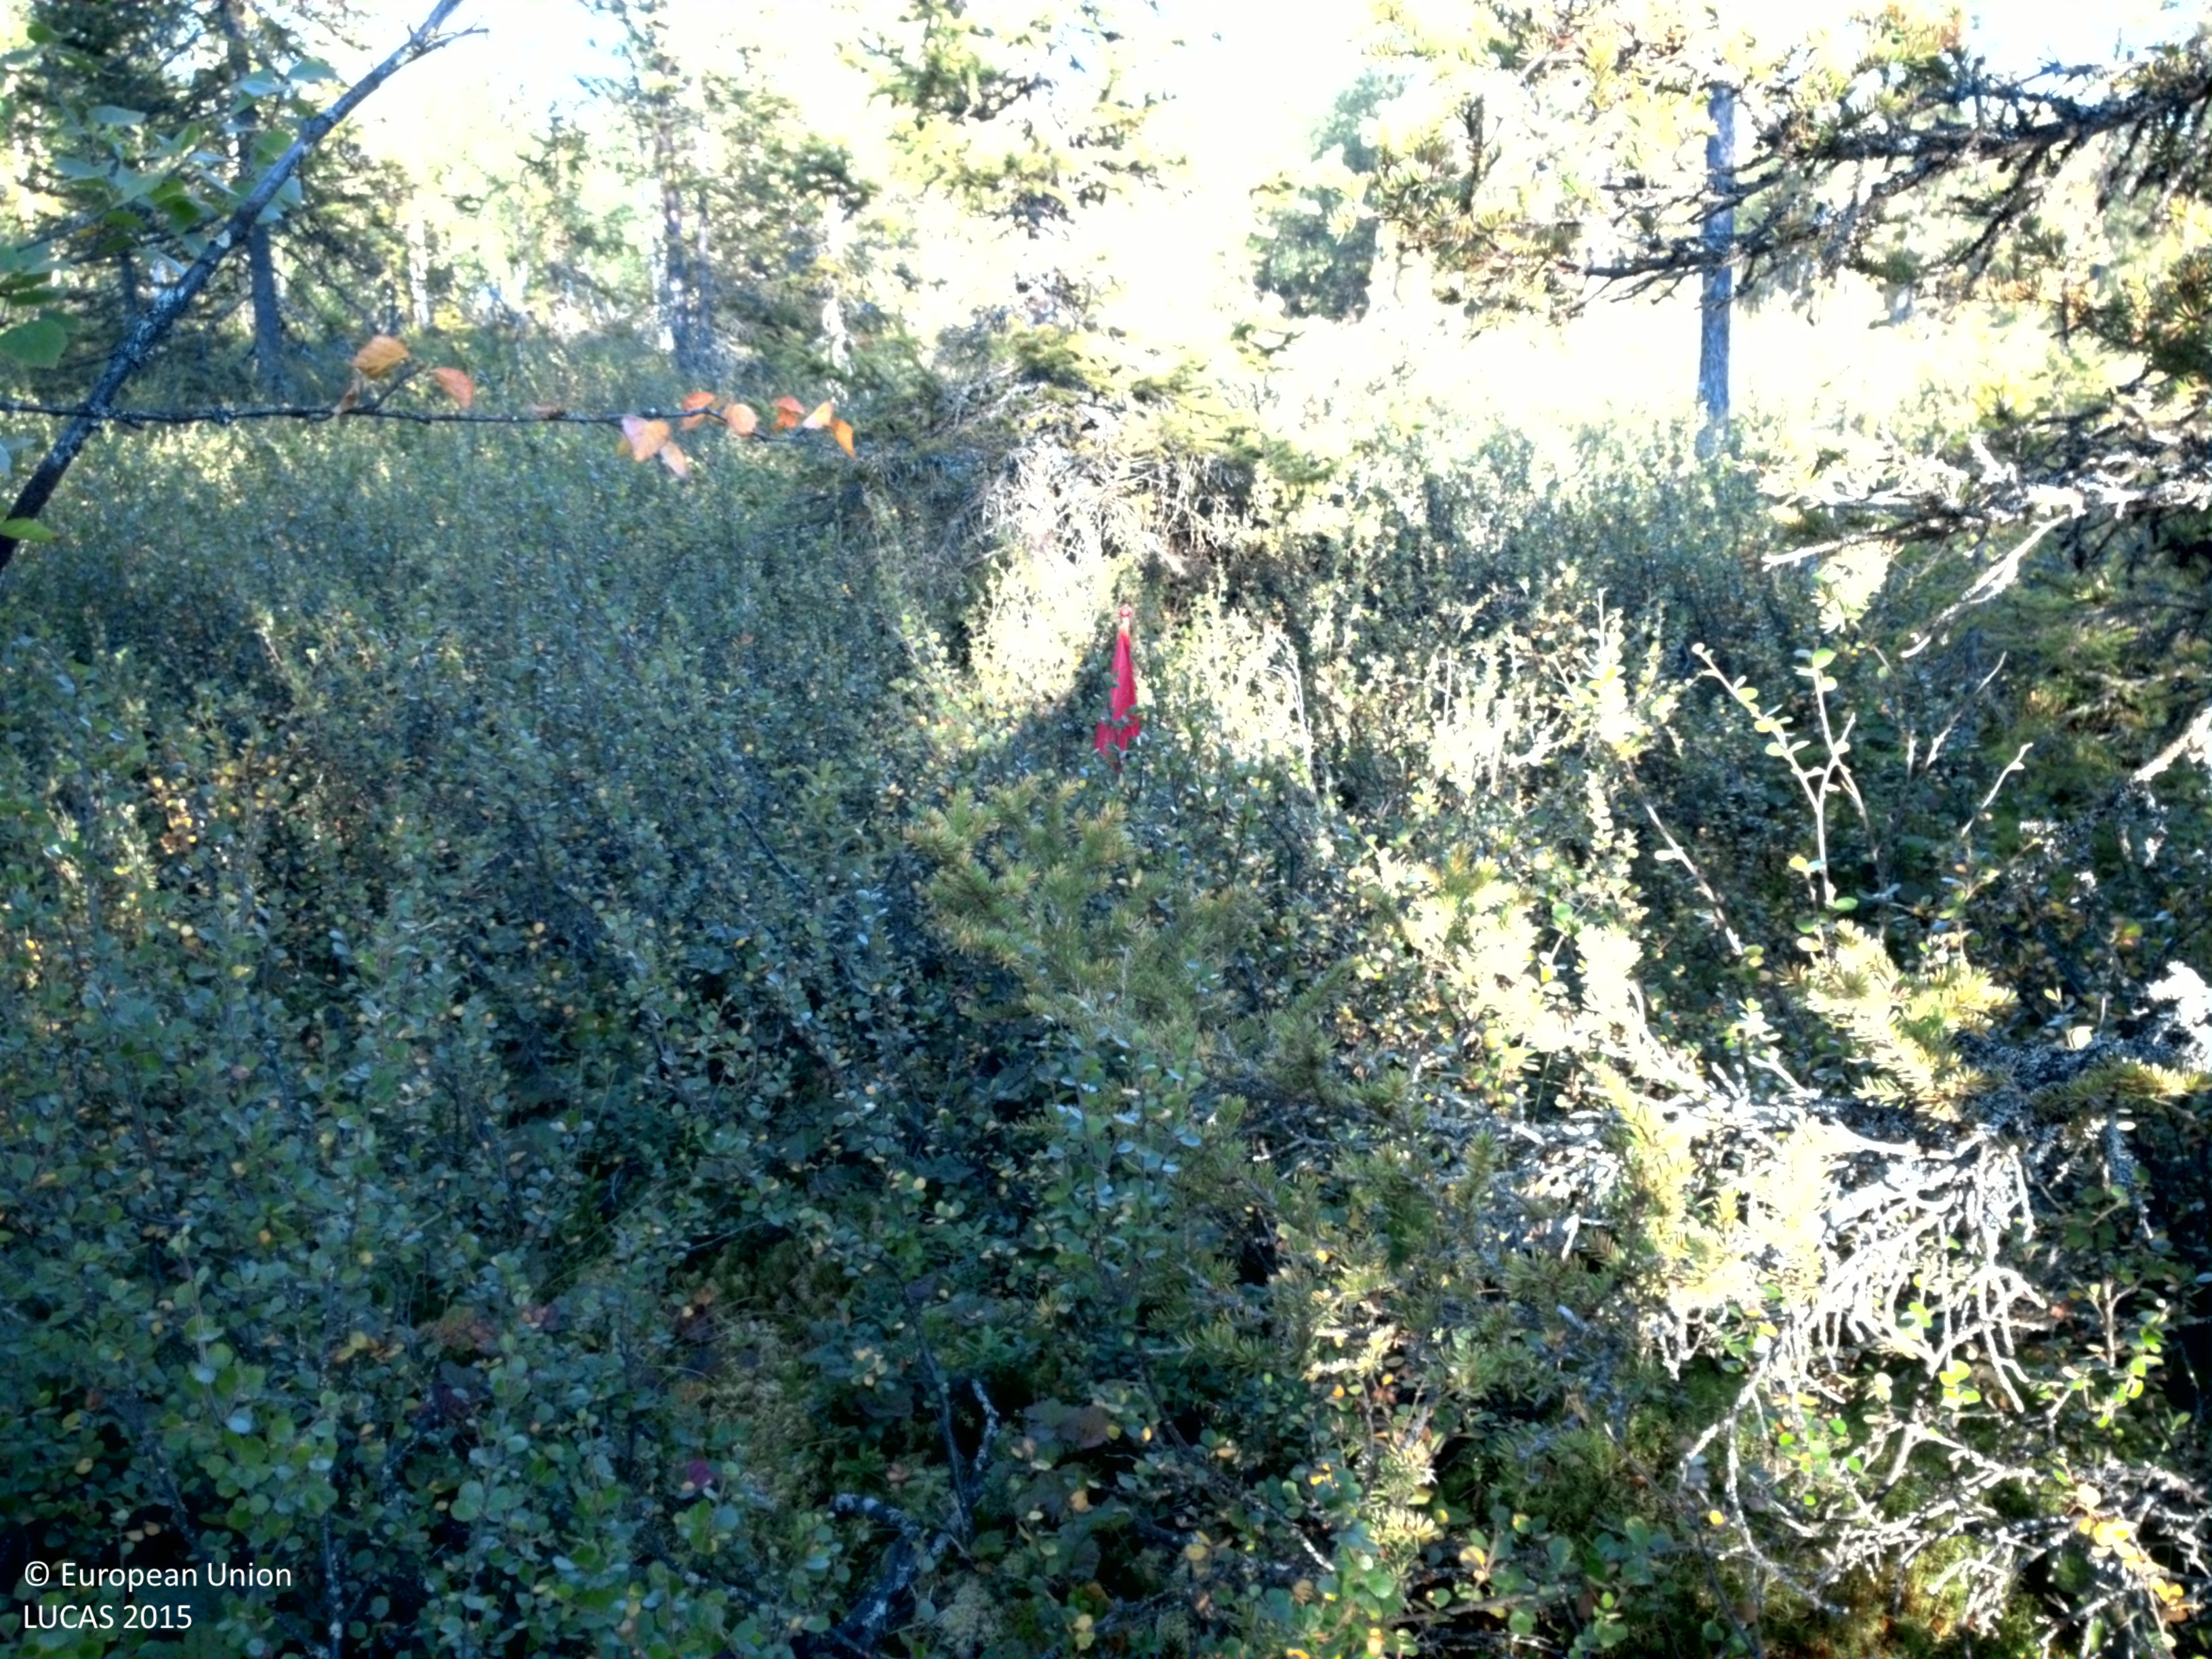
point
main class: Woodland
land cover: Spruce dominated coniferous woodland
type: boreal forest
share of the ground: 10 - 25 %
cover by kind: shrubs 85 %, coniferous forest trees 15 %
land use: Forestry
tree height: > 5 m
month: August
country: SE
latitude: 66.7937
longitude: 19.1593
